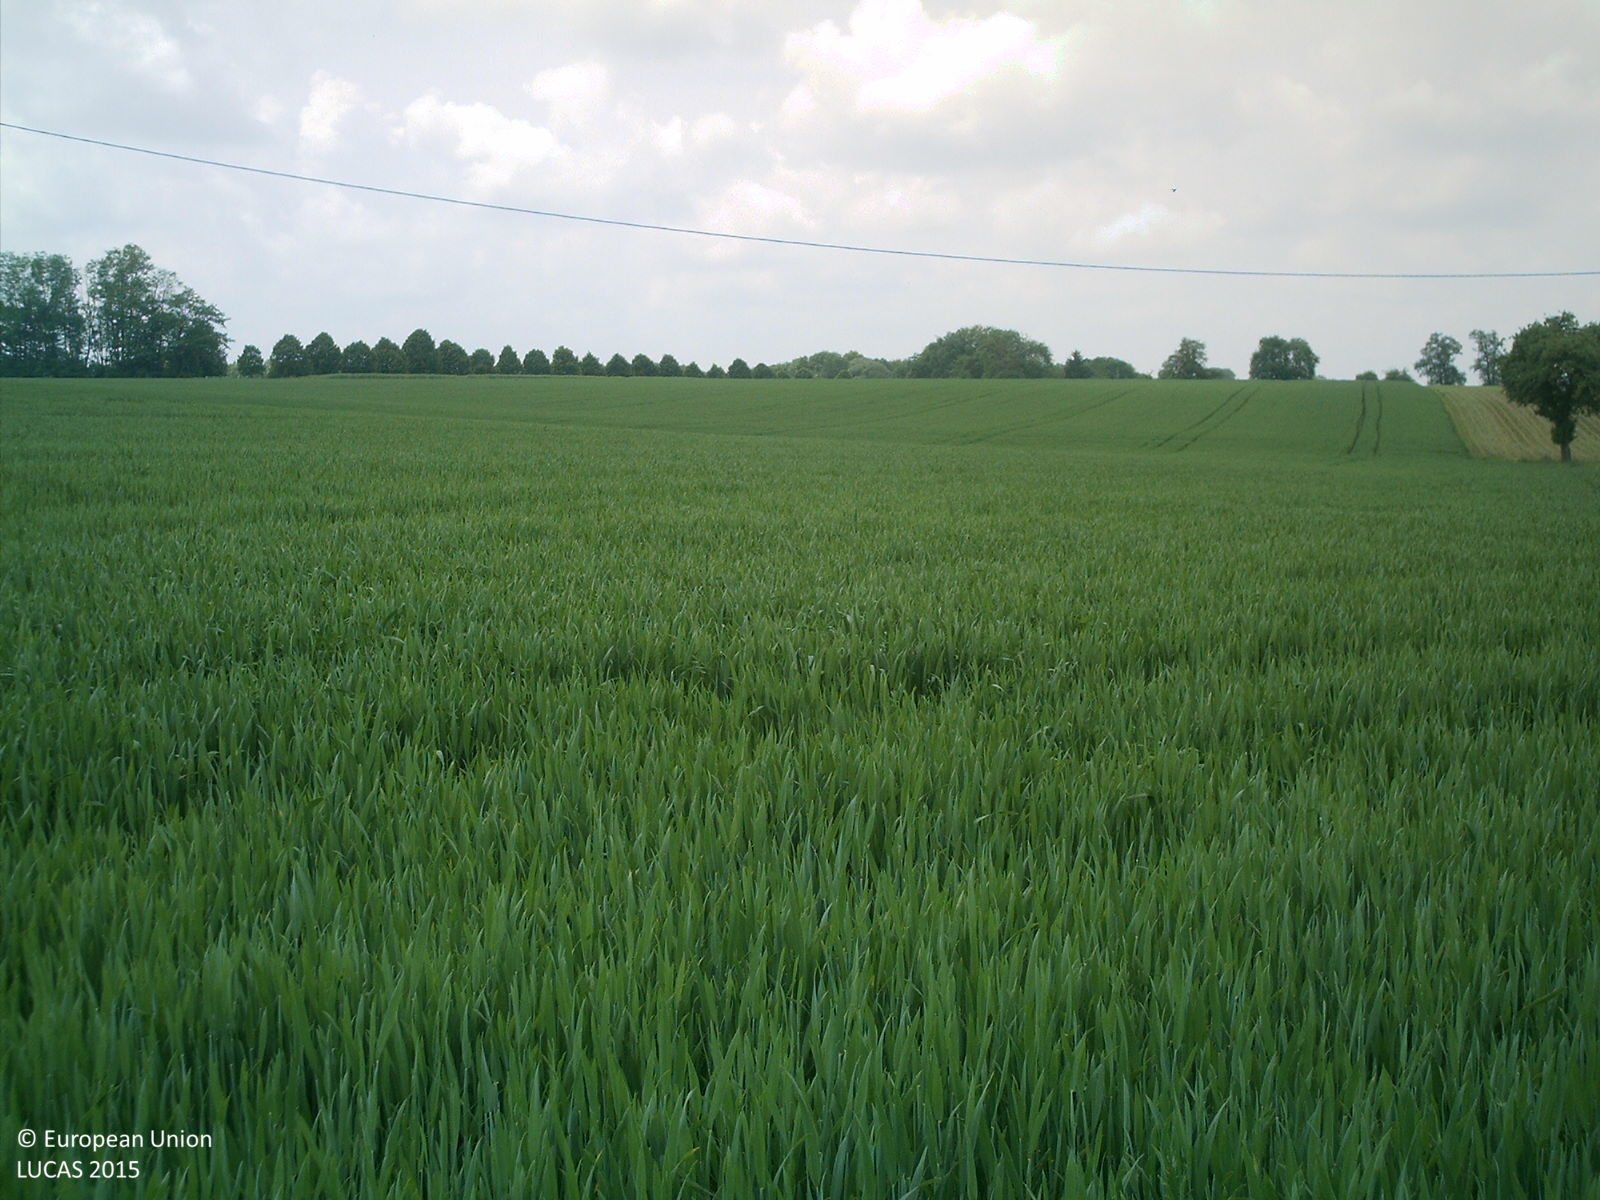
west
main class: Cropland
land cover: Common wheat
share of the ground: > 75 %
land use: Agriculture (excluding fallow land and kitchen gardens)
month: May
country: AT
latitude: 48.0735
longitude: 14.1470
